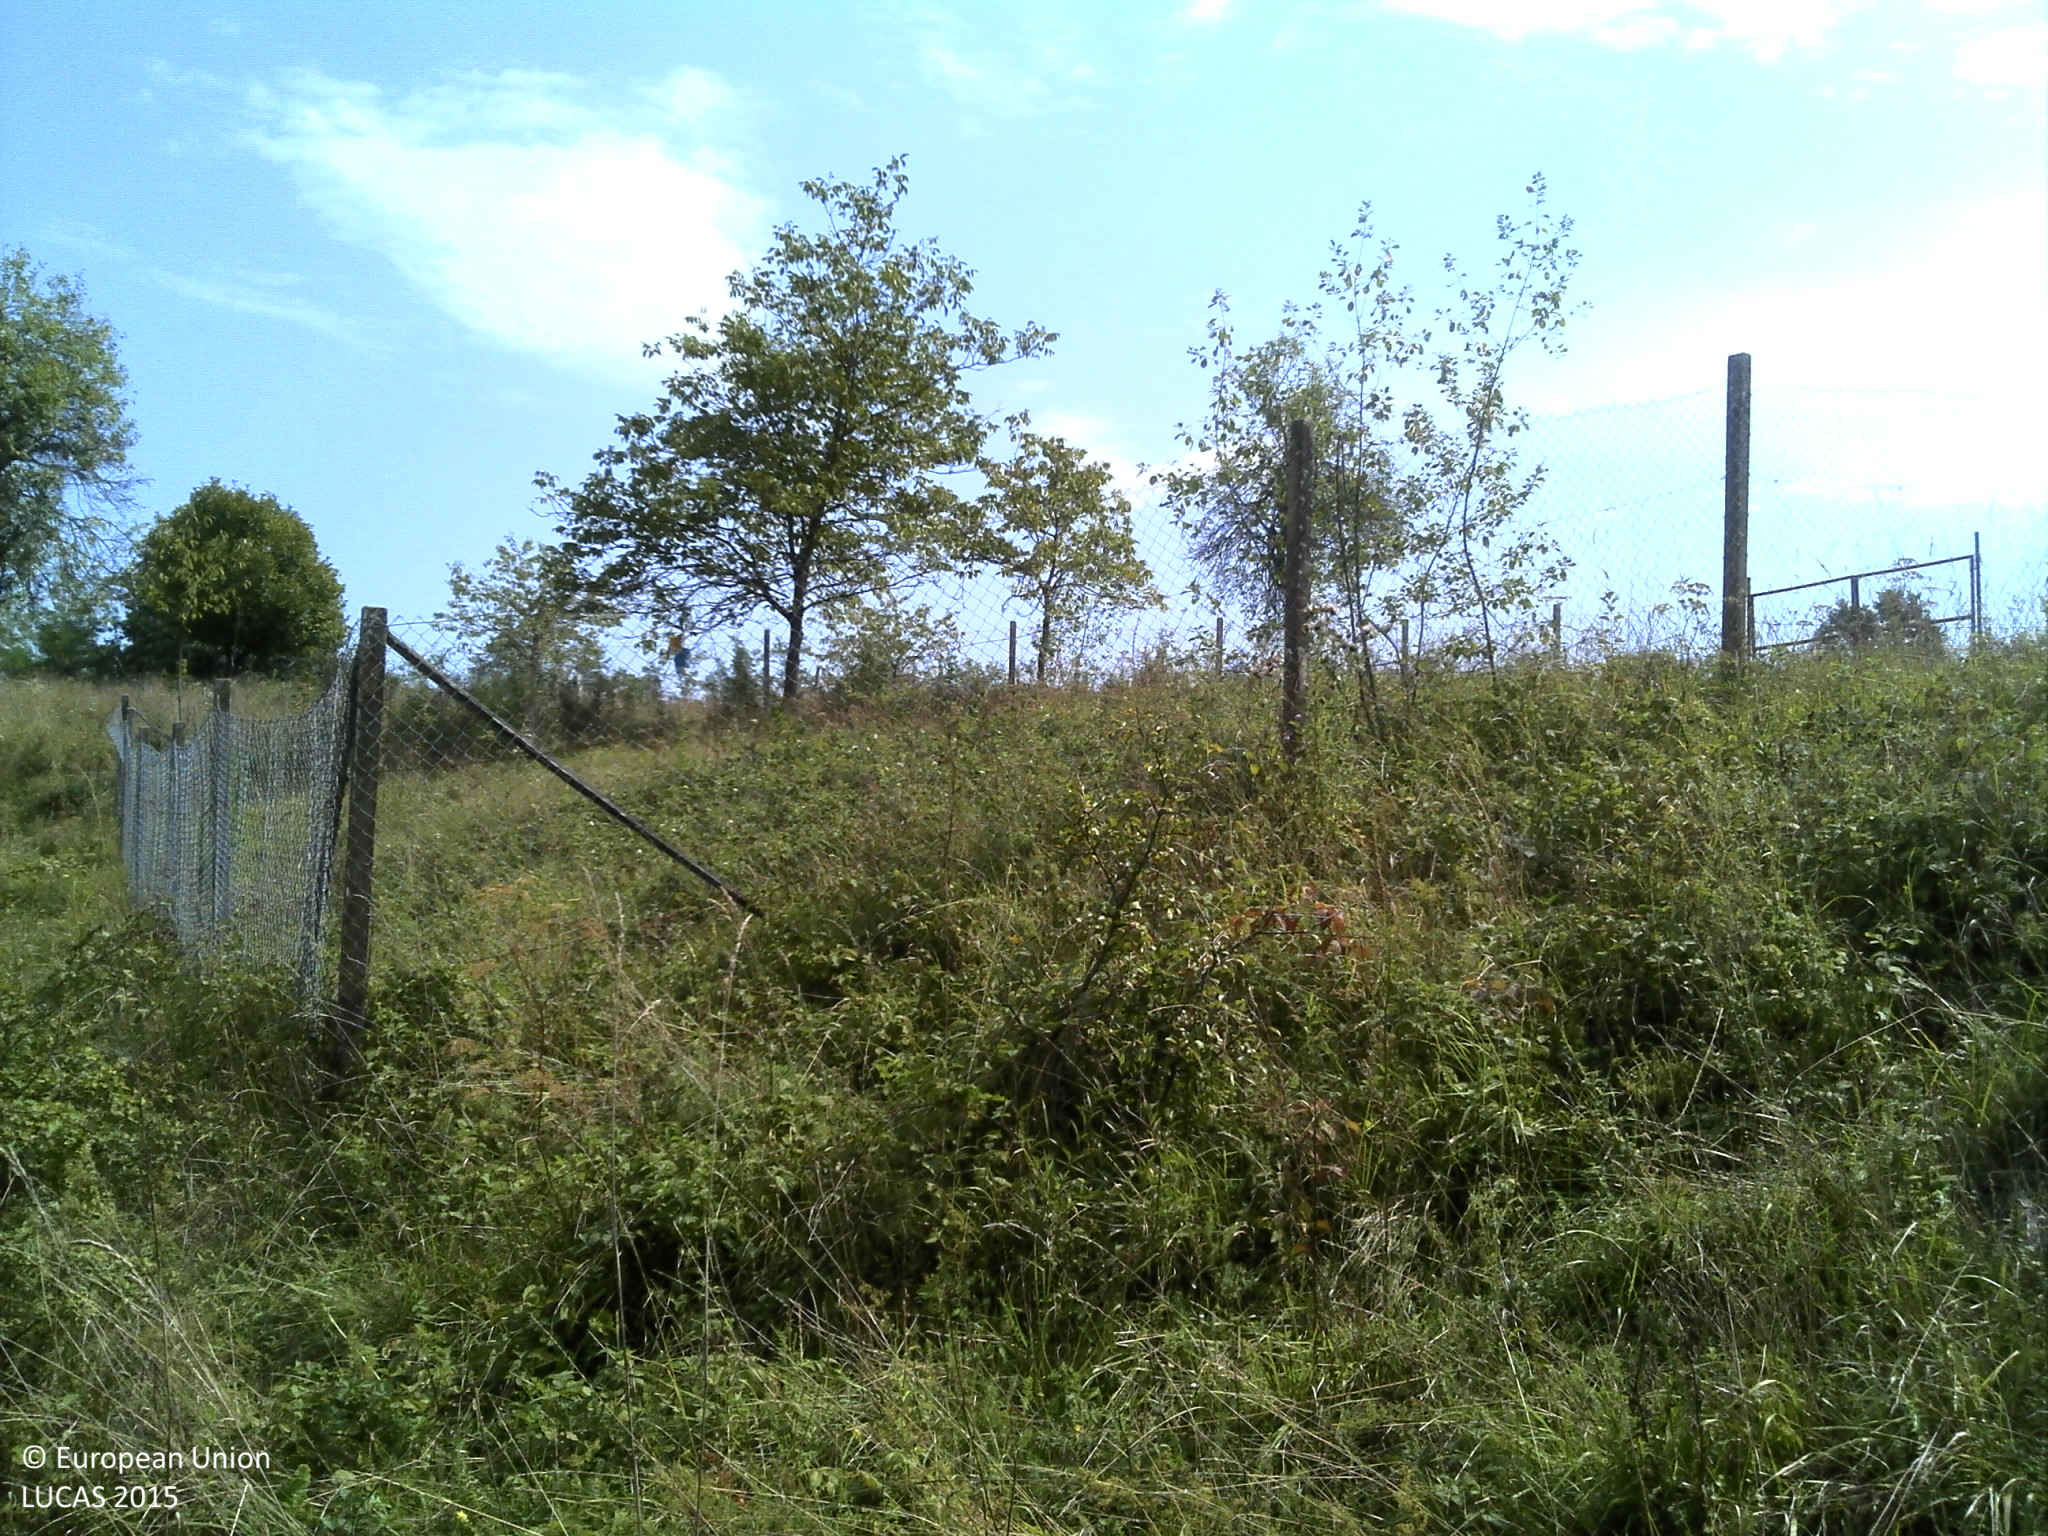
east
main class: Cropland
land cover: Lucerne
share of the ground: > 75 %
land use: Agriculture (excluding fallow land and kitchen gardens)
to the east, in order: Lucerne; Fences; Lucerne; Fences; Nuts trees; Spontaneously vegetated surfaces; Tracks; Spontaneously vegetated surfaces; Lucerne; Spontaneously vegetated surfaces; Broadleaved woodland; Spontaneously vegetated surfaces; Shrubland without tree cover; Spontaneously vegetated surfaces
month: September
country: HR
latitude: 45.4460
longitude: 15.2506
